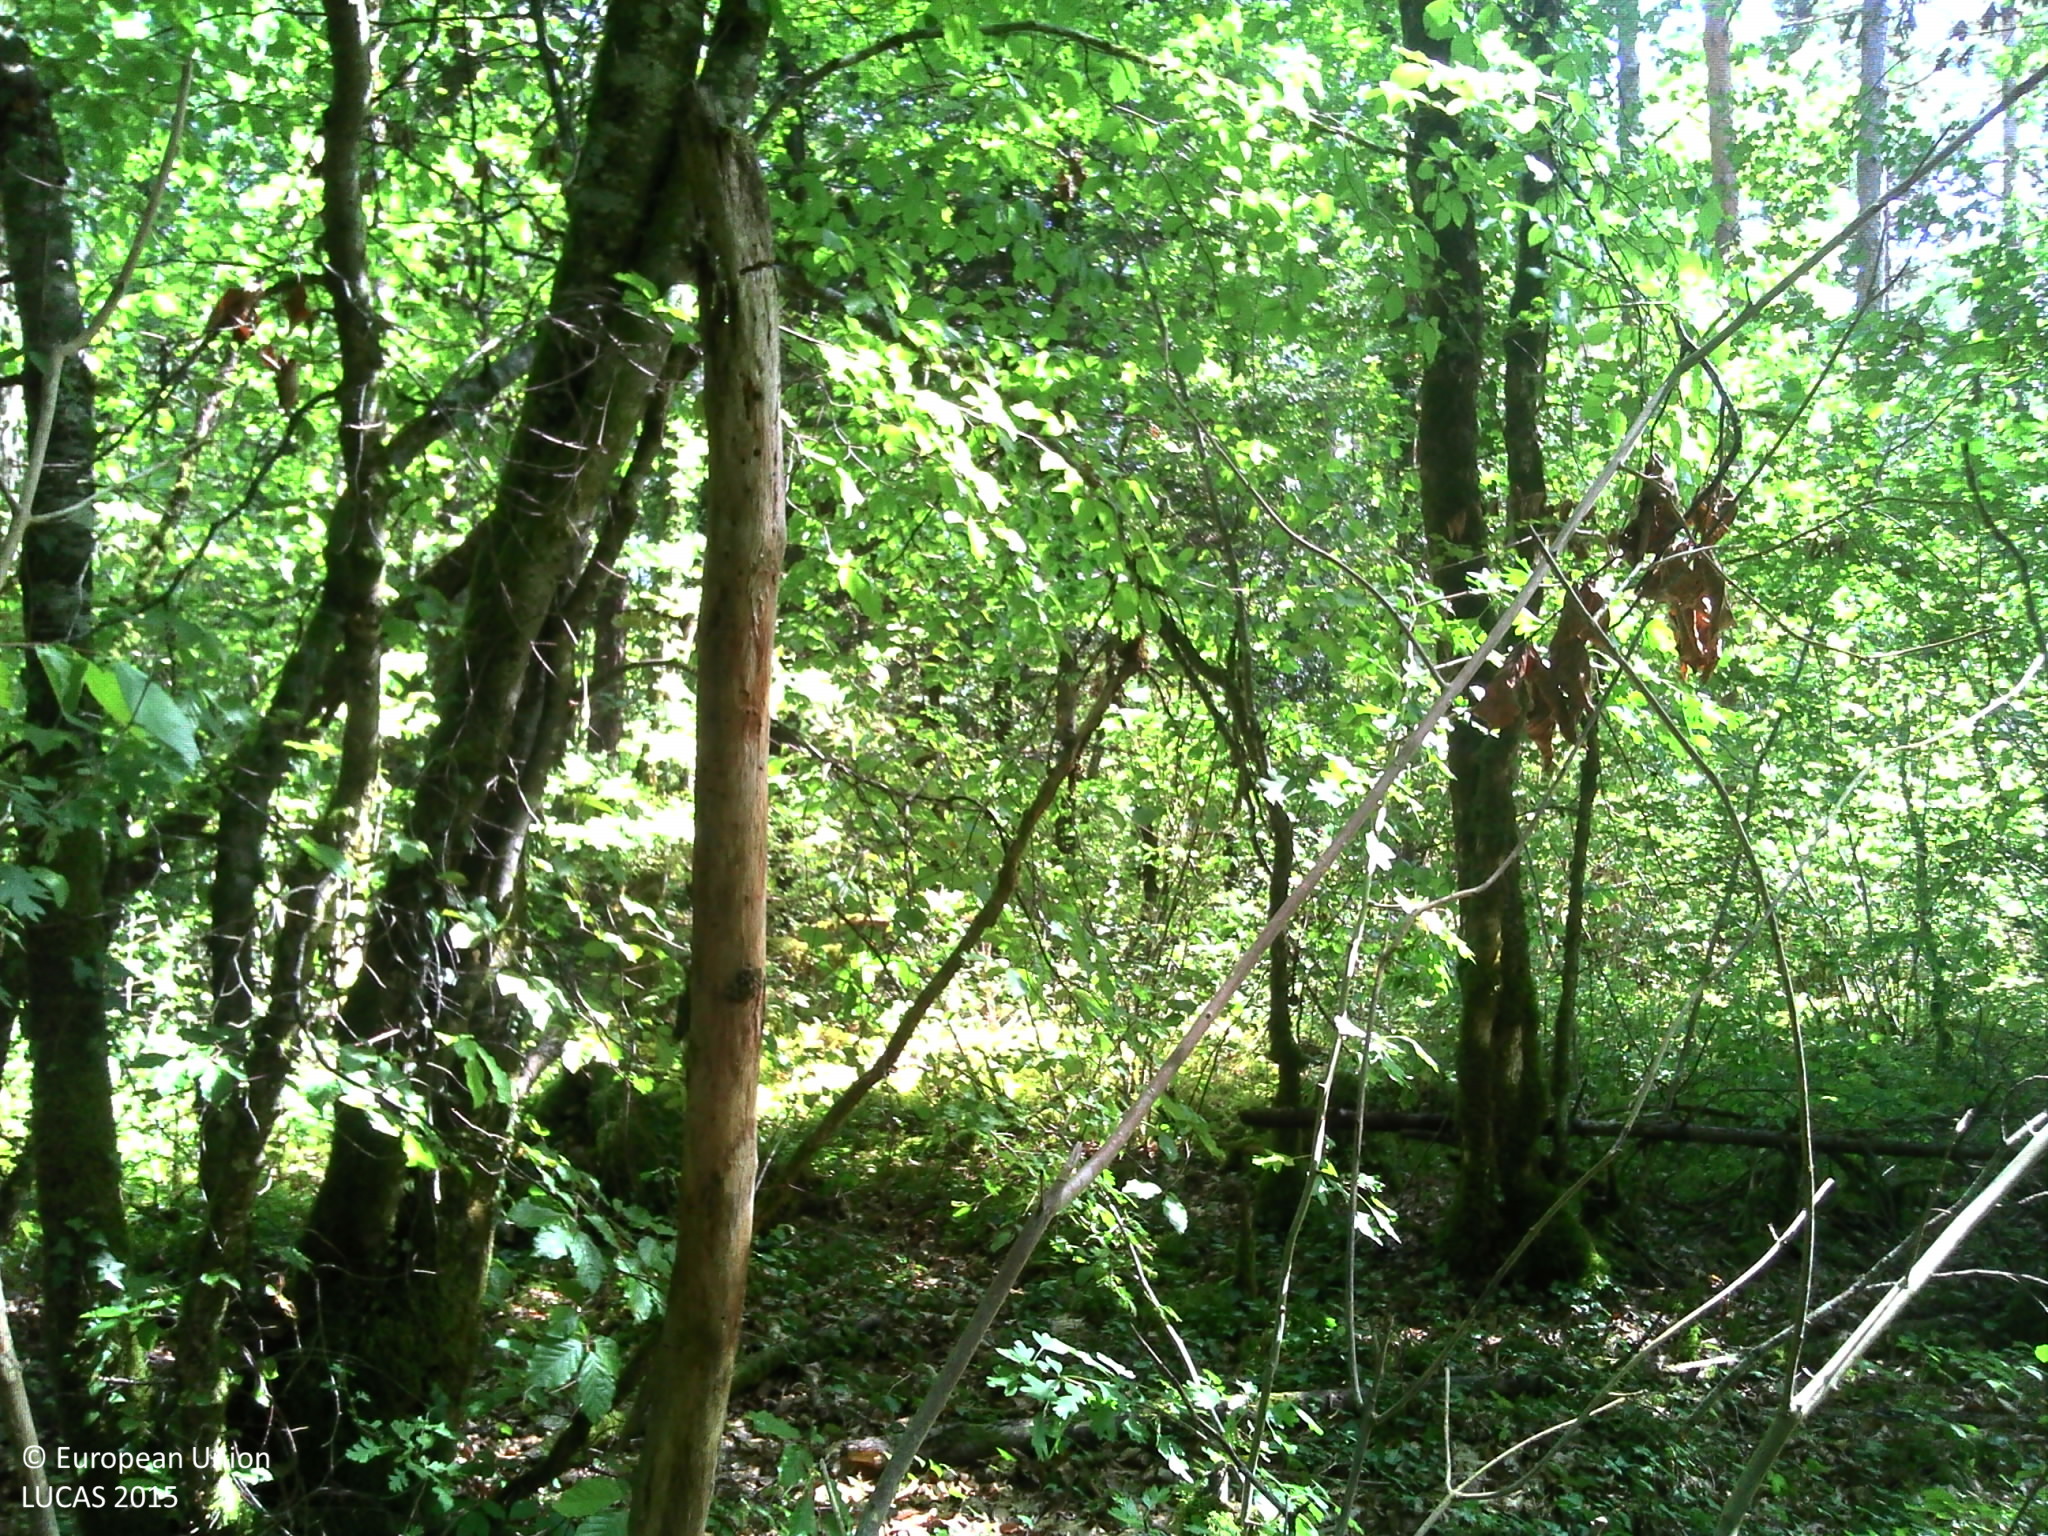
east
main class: Woodland
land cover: Pine dominated mixed woodland
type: acidophilous oak and oak-birch forest
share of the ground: > 75 %
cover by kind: coniferous forest trees 40 %, broadleaved forest trees 40 %, shrubs 10 %, herbaceous plants 10 %
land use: Forestry
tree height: > 5 m
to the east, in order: Pine dominated mixed woodland; Broadleaved woodland; Shrubland with sparse tree cover; Broadleaved woodland; Rocks and stones; Broadleaved woodland; Tracks; Broadleaved woodland
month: August
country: FR
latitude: 47.3087
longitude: 4.8283
